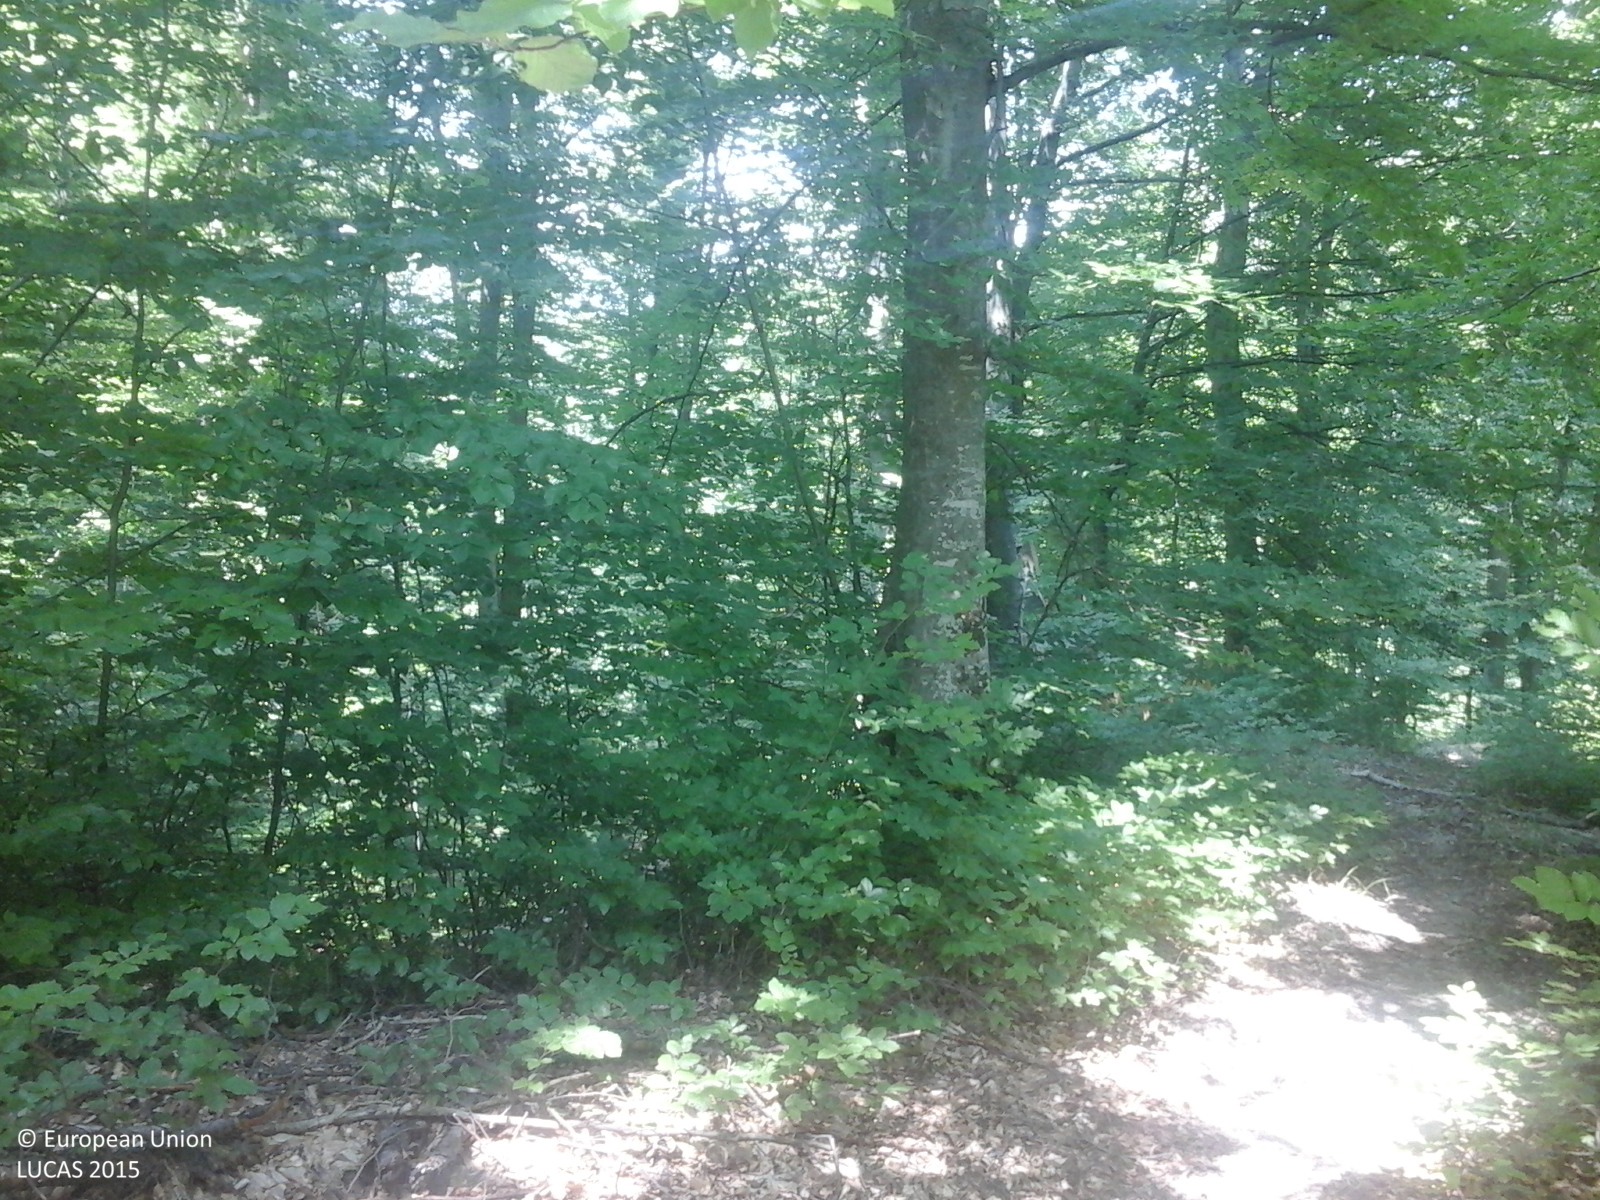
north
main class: Woodland
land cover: Broadleaved woodland
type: beech forest
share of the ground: > 75 %
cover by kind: broadleaved forest trees 100 %
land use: Forestry
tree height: > 5 m
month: July
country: RO
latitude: 45.0365
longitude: 25.0791
